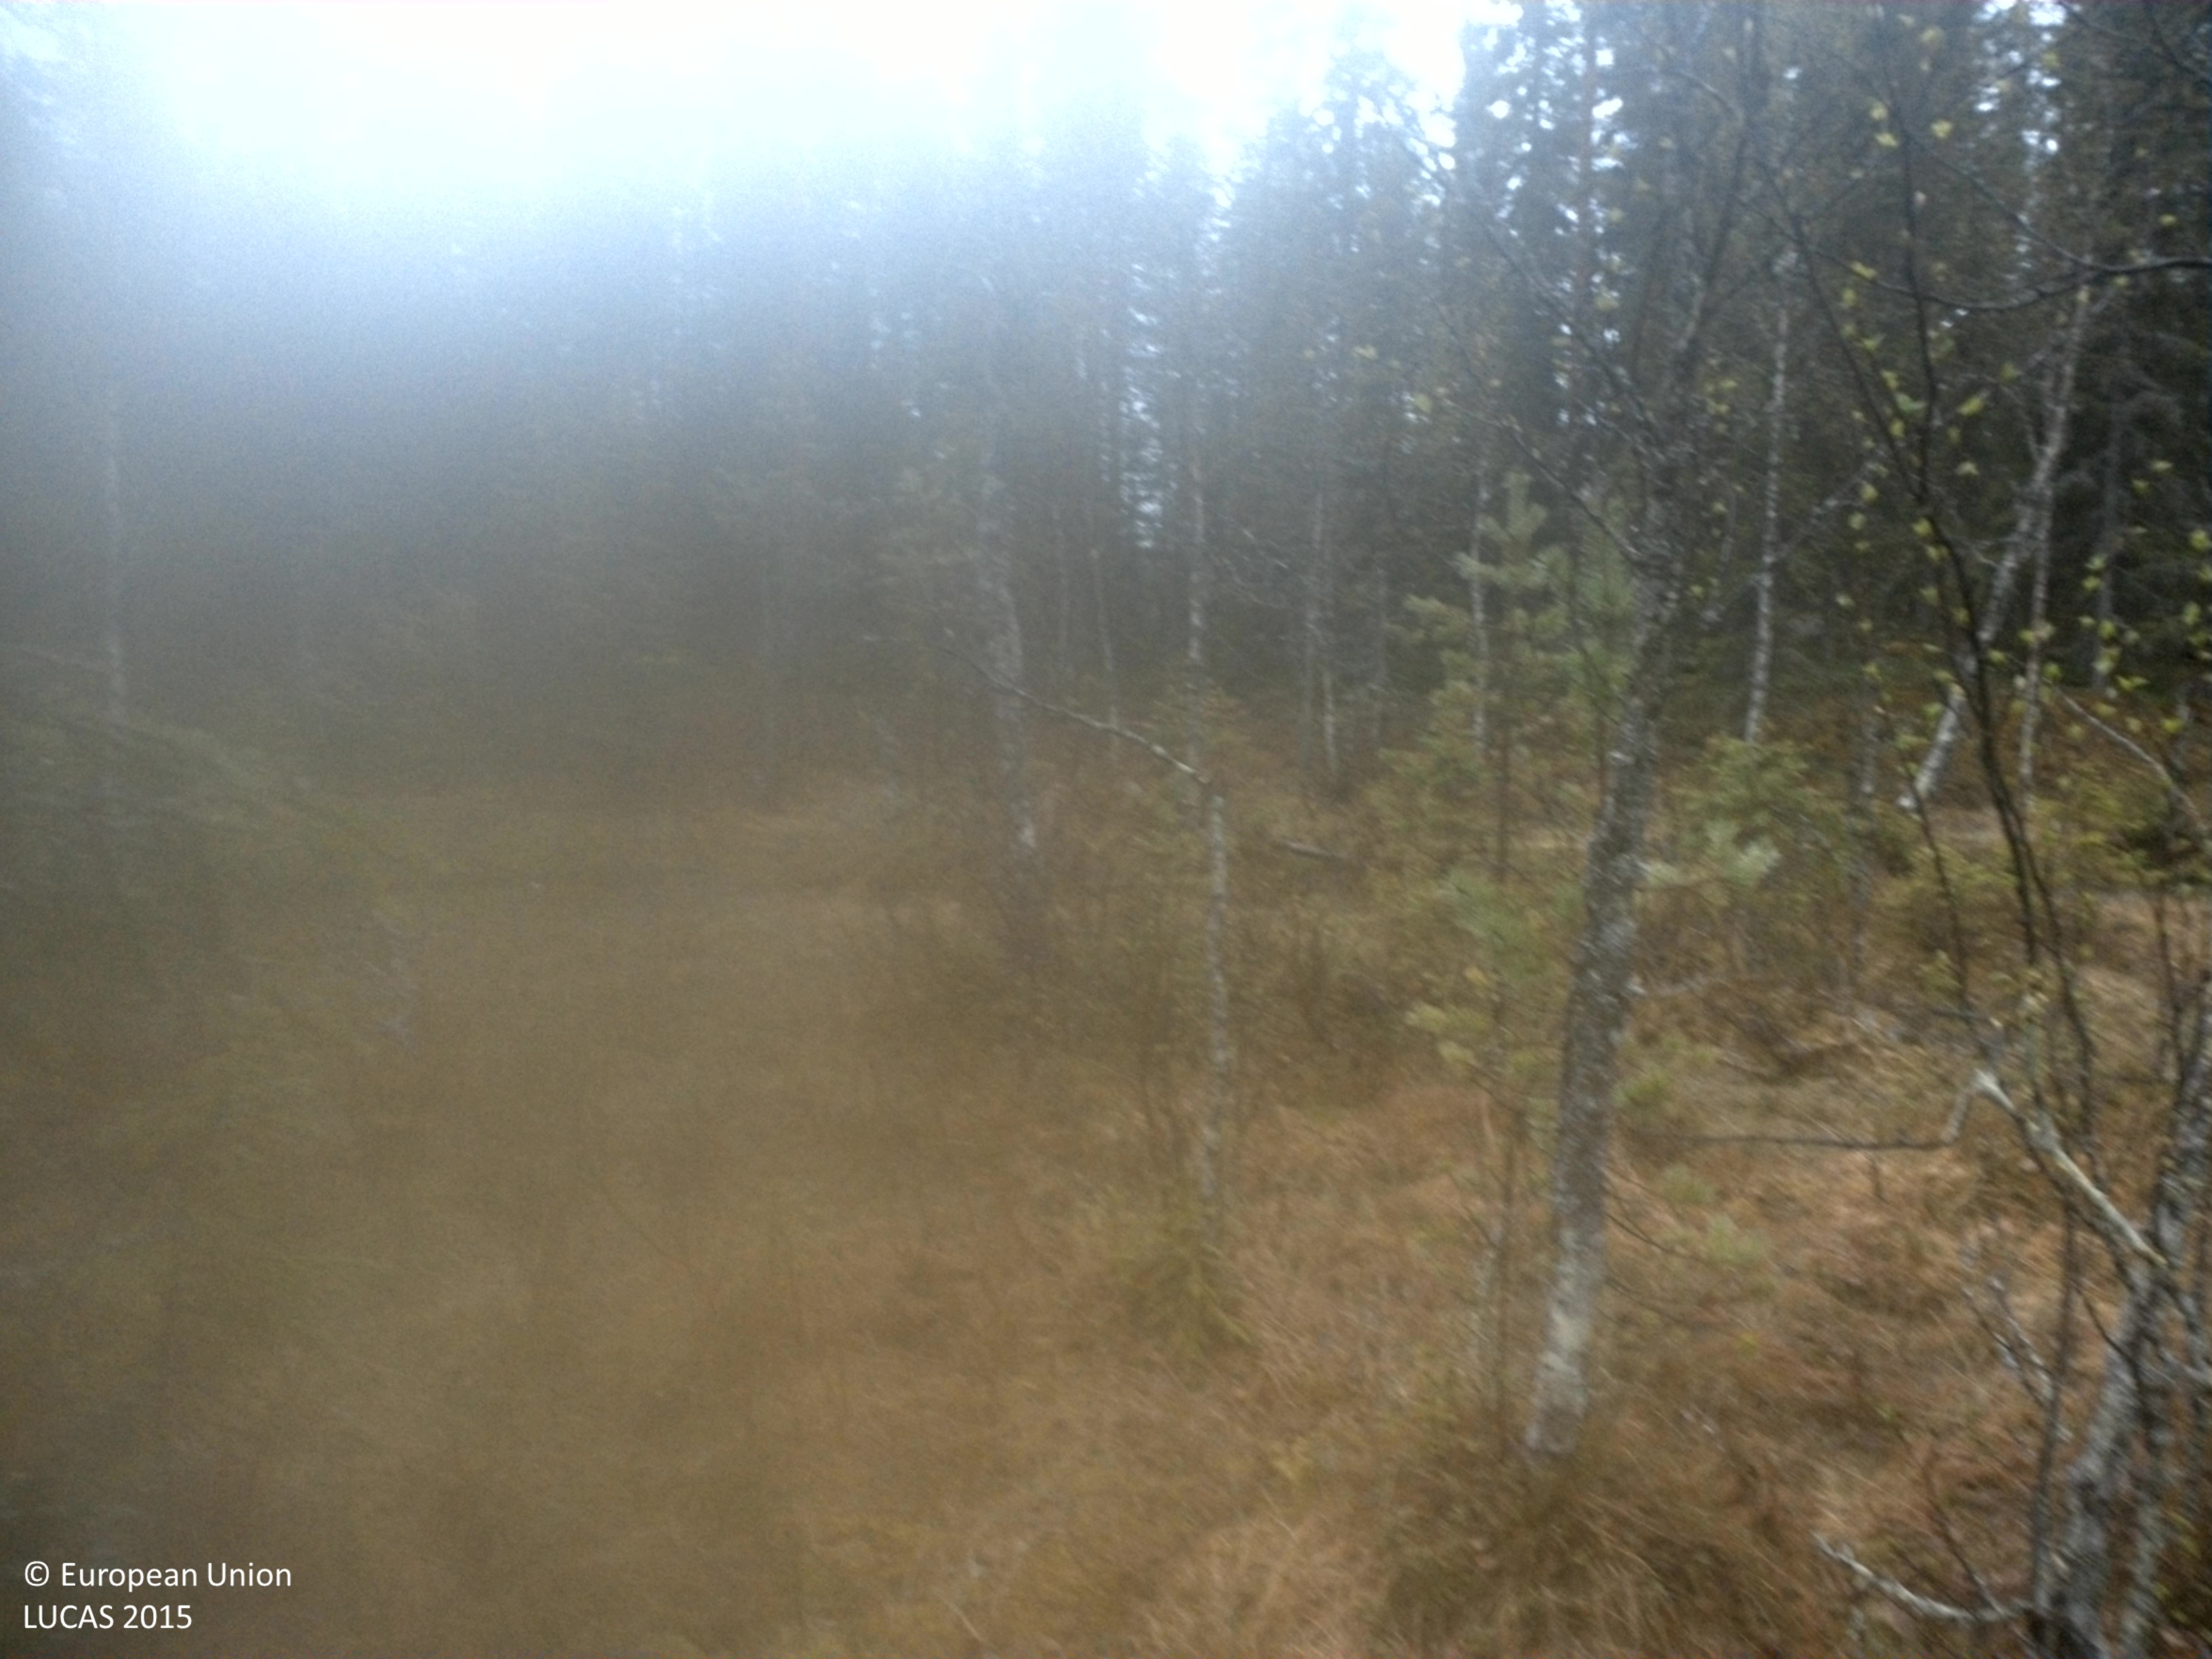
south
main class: Woodland
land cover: Spruce dominated mixed woodland
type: boreal forest
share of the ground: 25 - 50 %
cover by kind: lichens and mosses 35 %, coniferous forest trees 30 %, herbaceous plants 20 %, broadleaved forest trees 10 %, shrubs 5 %
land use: Forestry
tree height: > 5 m
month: June
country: SE
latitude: 64.3185
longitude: 18.0968
